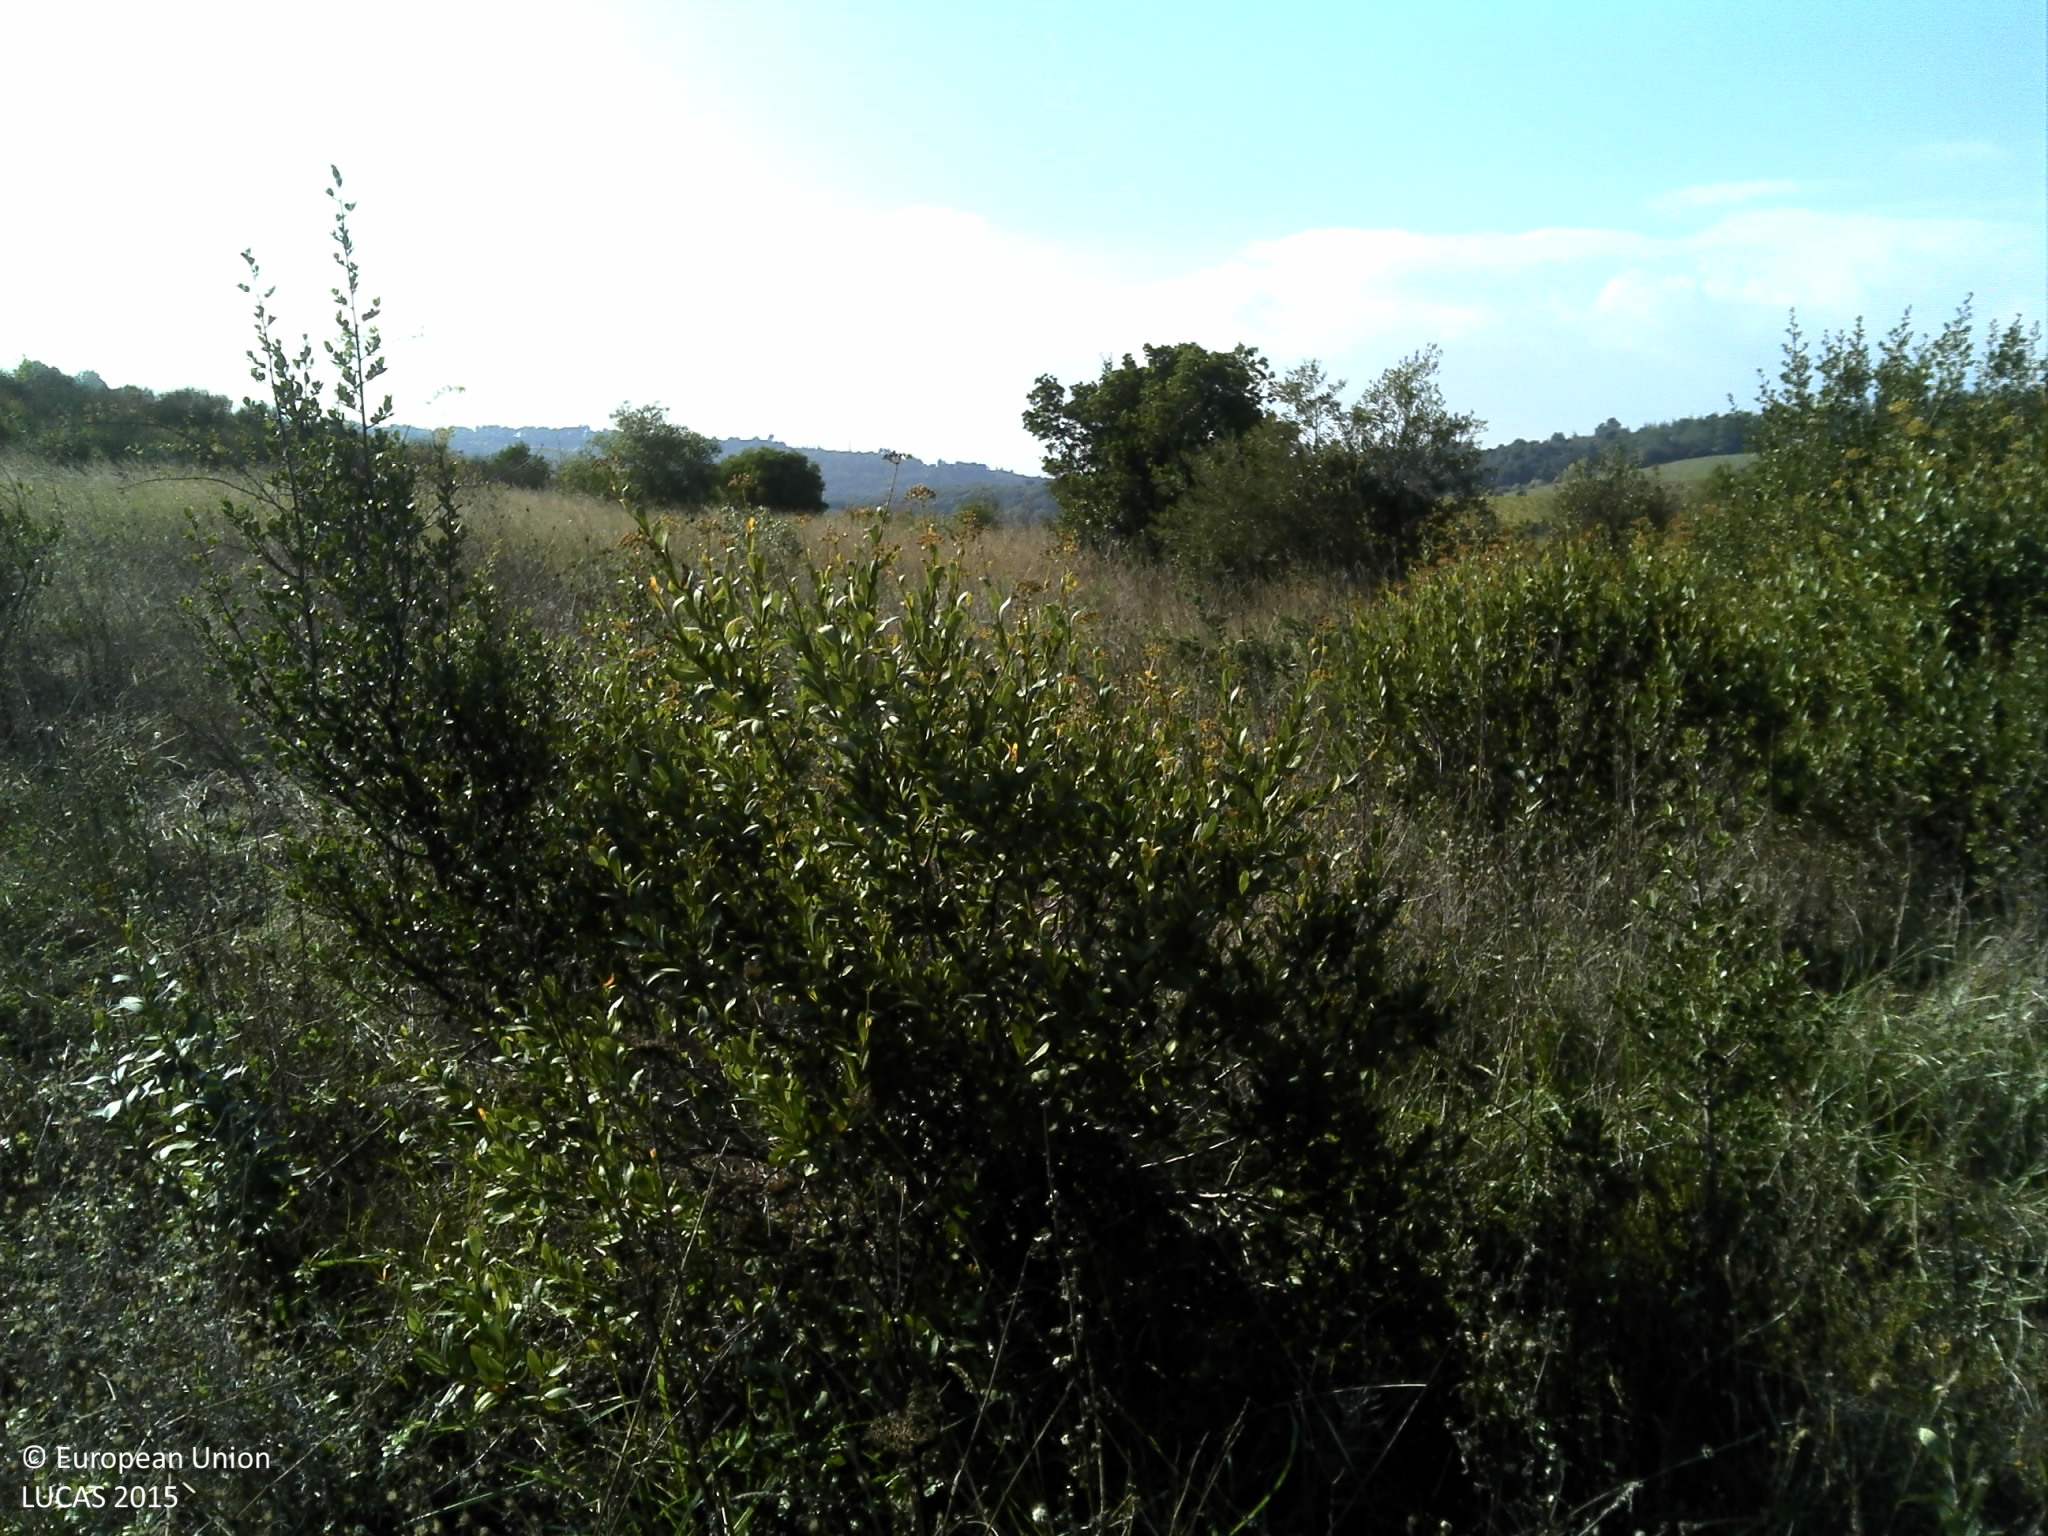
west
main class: Shrubland
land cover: Shrubland with sparse tree cover
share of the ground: > 75 %
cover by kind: shrubs 80 %, herbaceous plants 15 %, broadleaved forest trees 5 %
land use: Semi-natural and natural areas not in use
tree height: < 5 m
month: October
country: FR
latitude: 43.3555
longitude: 2.7660
